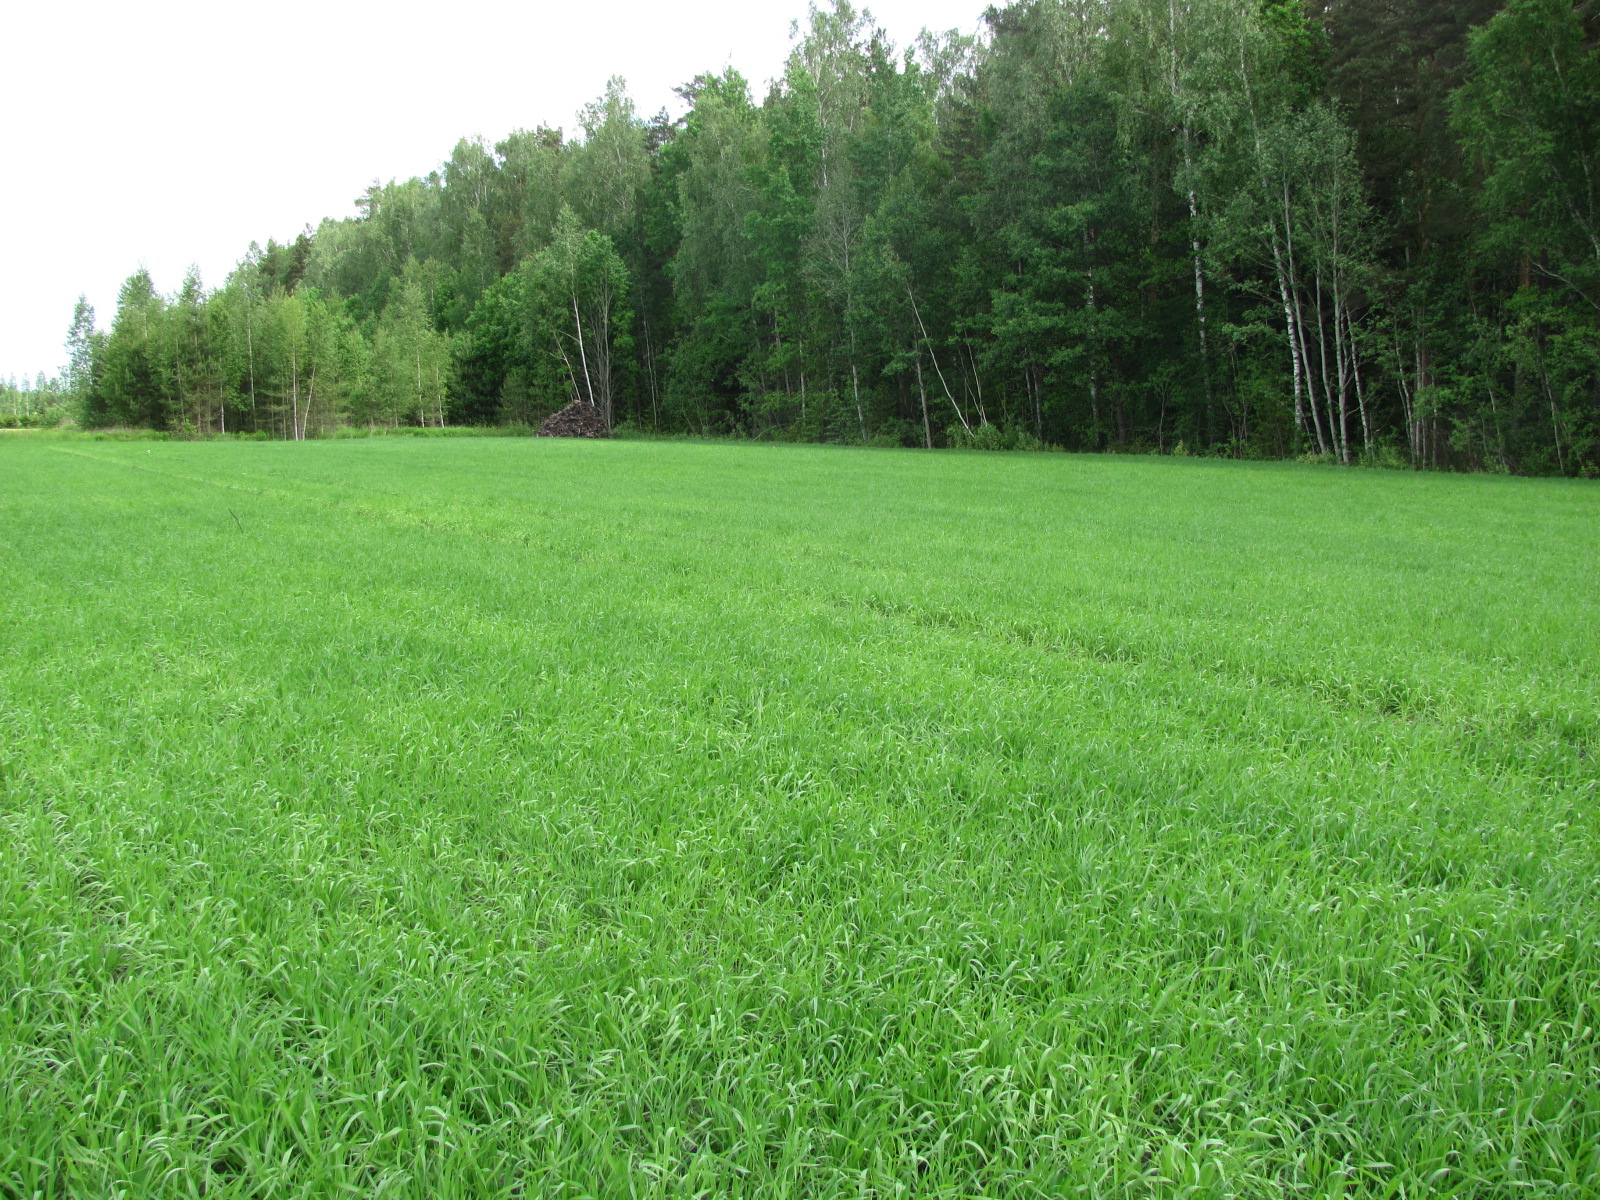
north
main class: Cropland
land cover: Common wheat
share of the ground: > 75 %
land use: Agriculture (excluding fallow land and kitchen gardens)
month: June
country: LV
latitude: 56.6899
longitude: 23.8781
